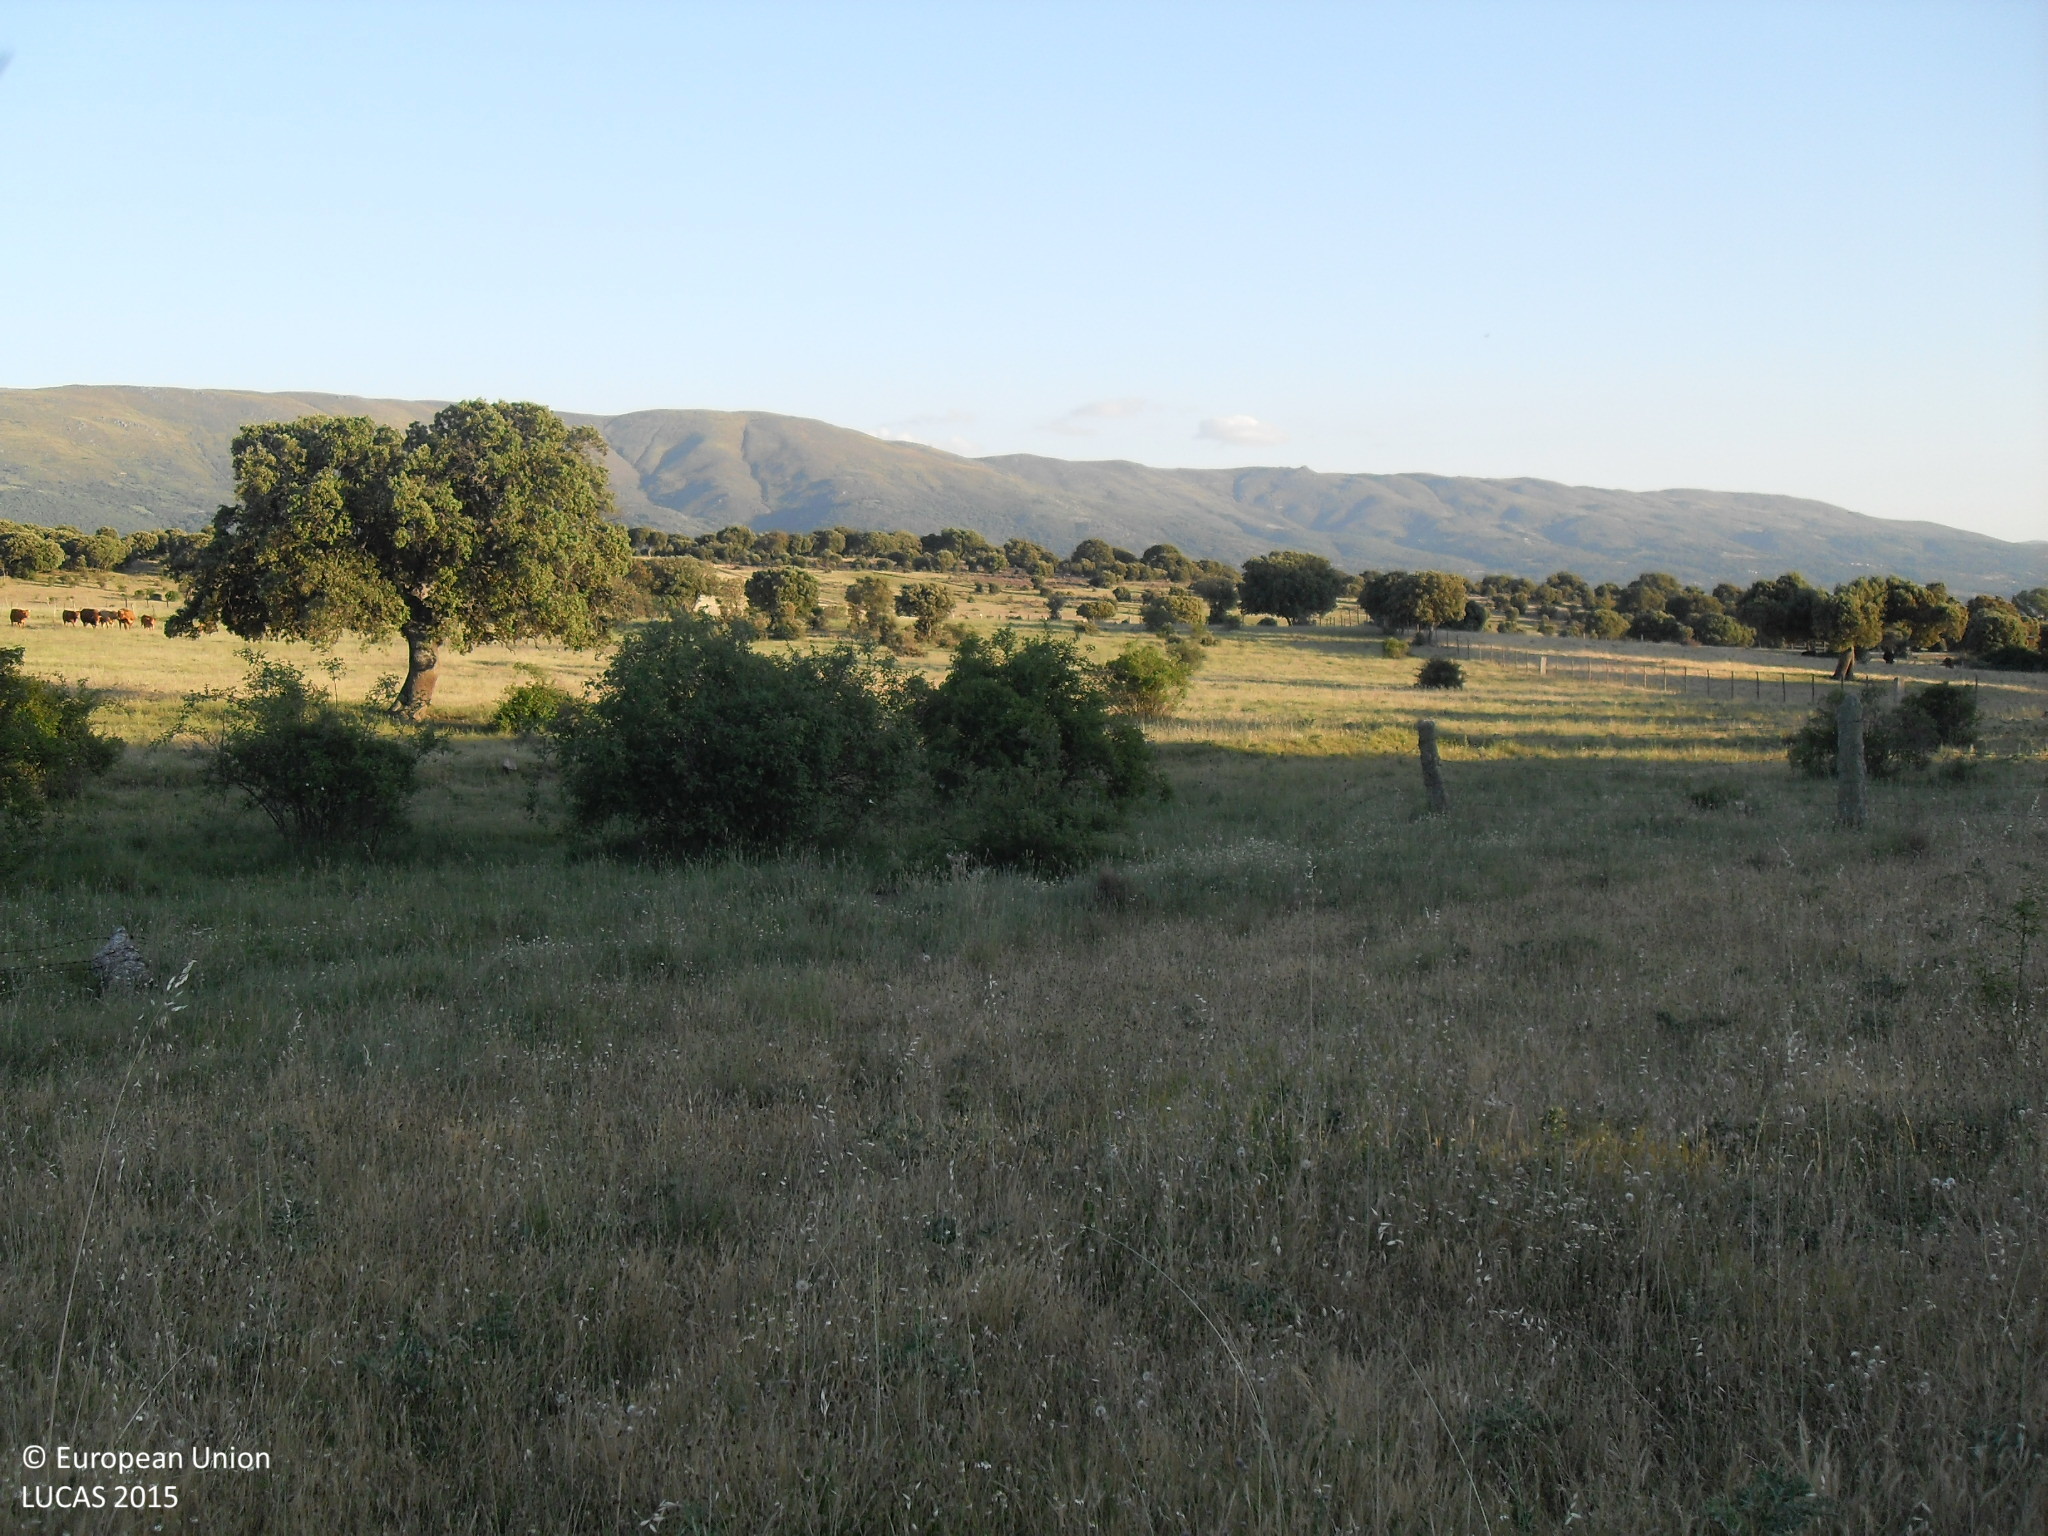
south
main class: Grassland
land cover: Grassland without tree/shrub cover
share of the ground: > 75 %
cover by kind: herbaceous plants 100 %
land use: Agriculture (excluding fallow land and kitchen gardens)
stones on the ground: < 10 %
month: May
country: ES
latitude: 40.5321
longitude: -5.2809
